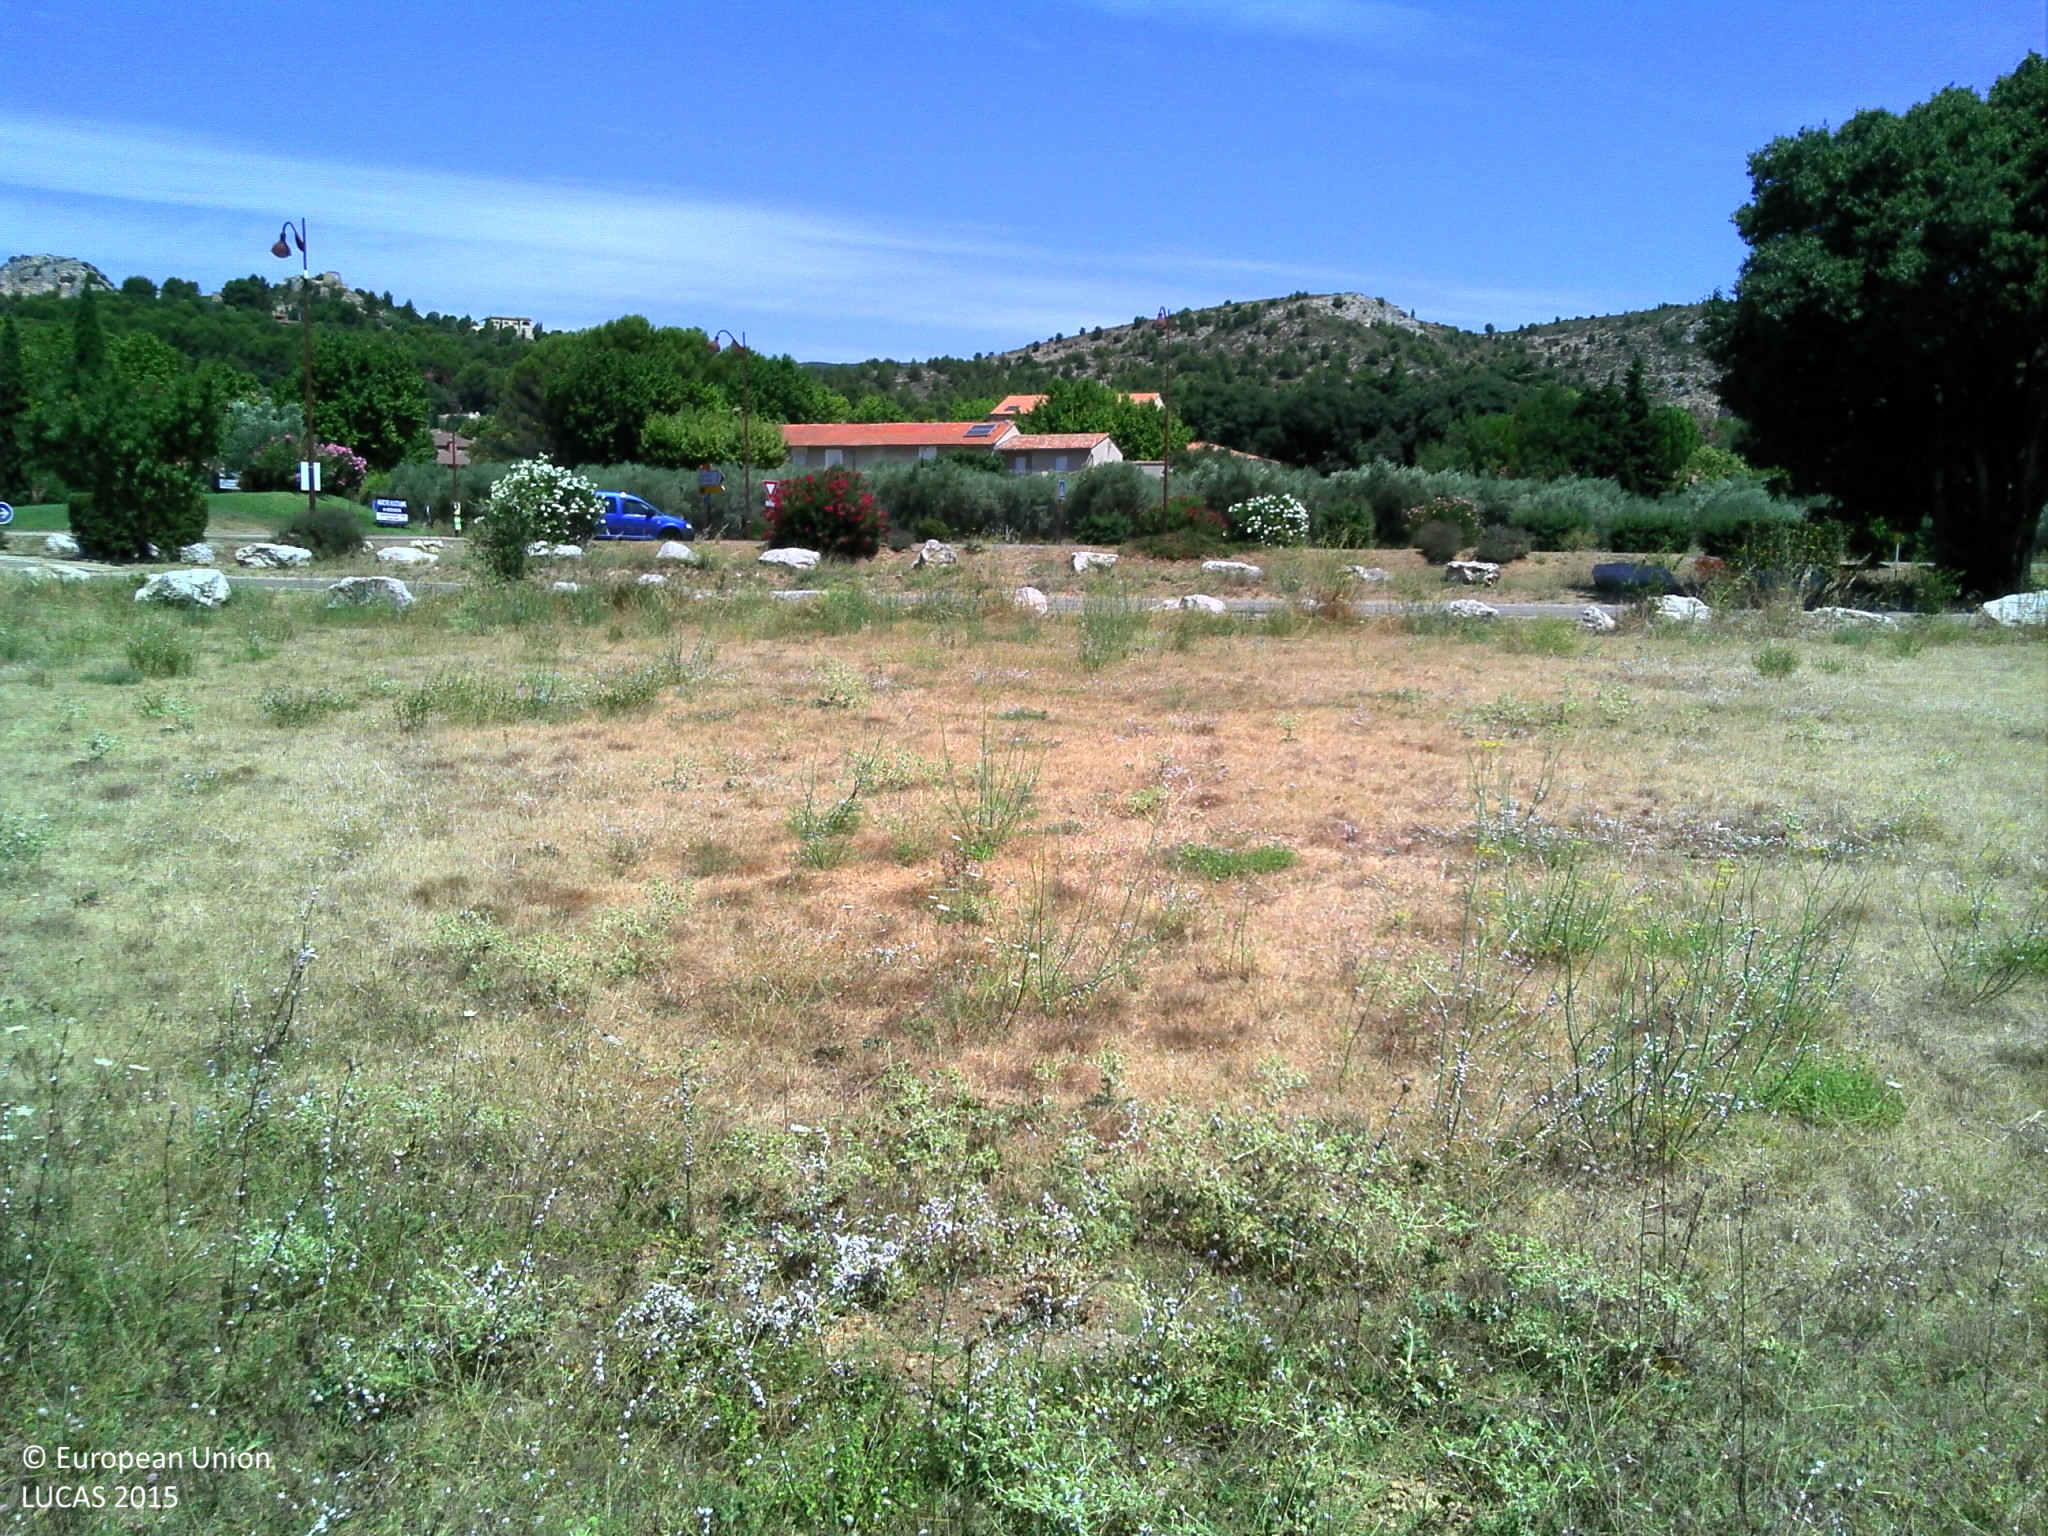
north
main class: Grassland
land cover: Grassland without tree/shrub cover
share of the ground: > 75 %
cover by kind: herbaceous plants 95 %, unconsolidated bare surface 5 %
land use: Agriculture (excluding fallow land and kitchen gardens)
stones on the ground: < 10 %
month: July
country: FR
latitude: 43.7518
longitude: 5.2029
